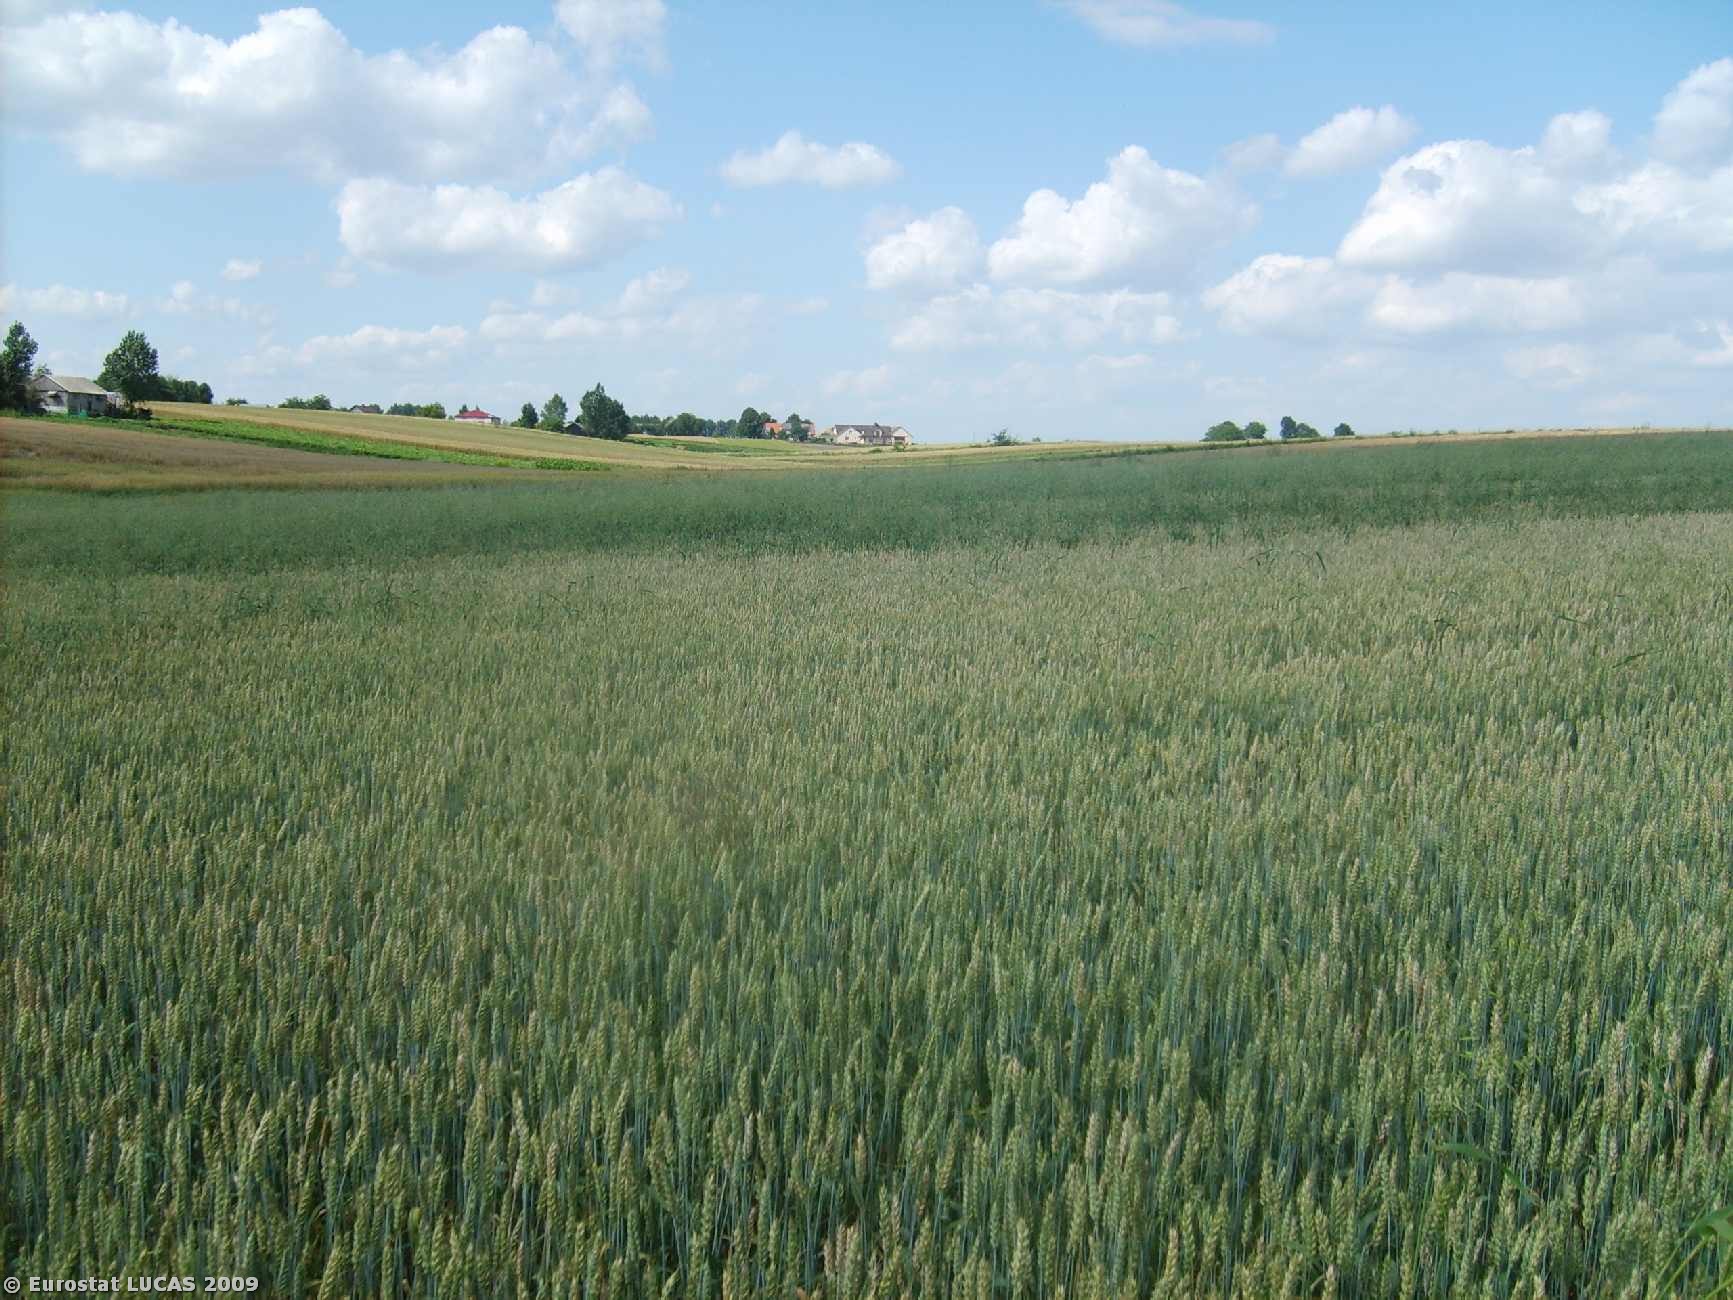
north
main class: Cropland
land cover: Common wheat
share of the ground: > 75 %
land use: Agriculture (excluding fallow land and kitchen gardens)
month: July
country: PL
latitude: 50.5419
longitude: 23.8199
